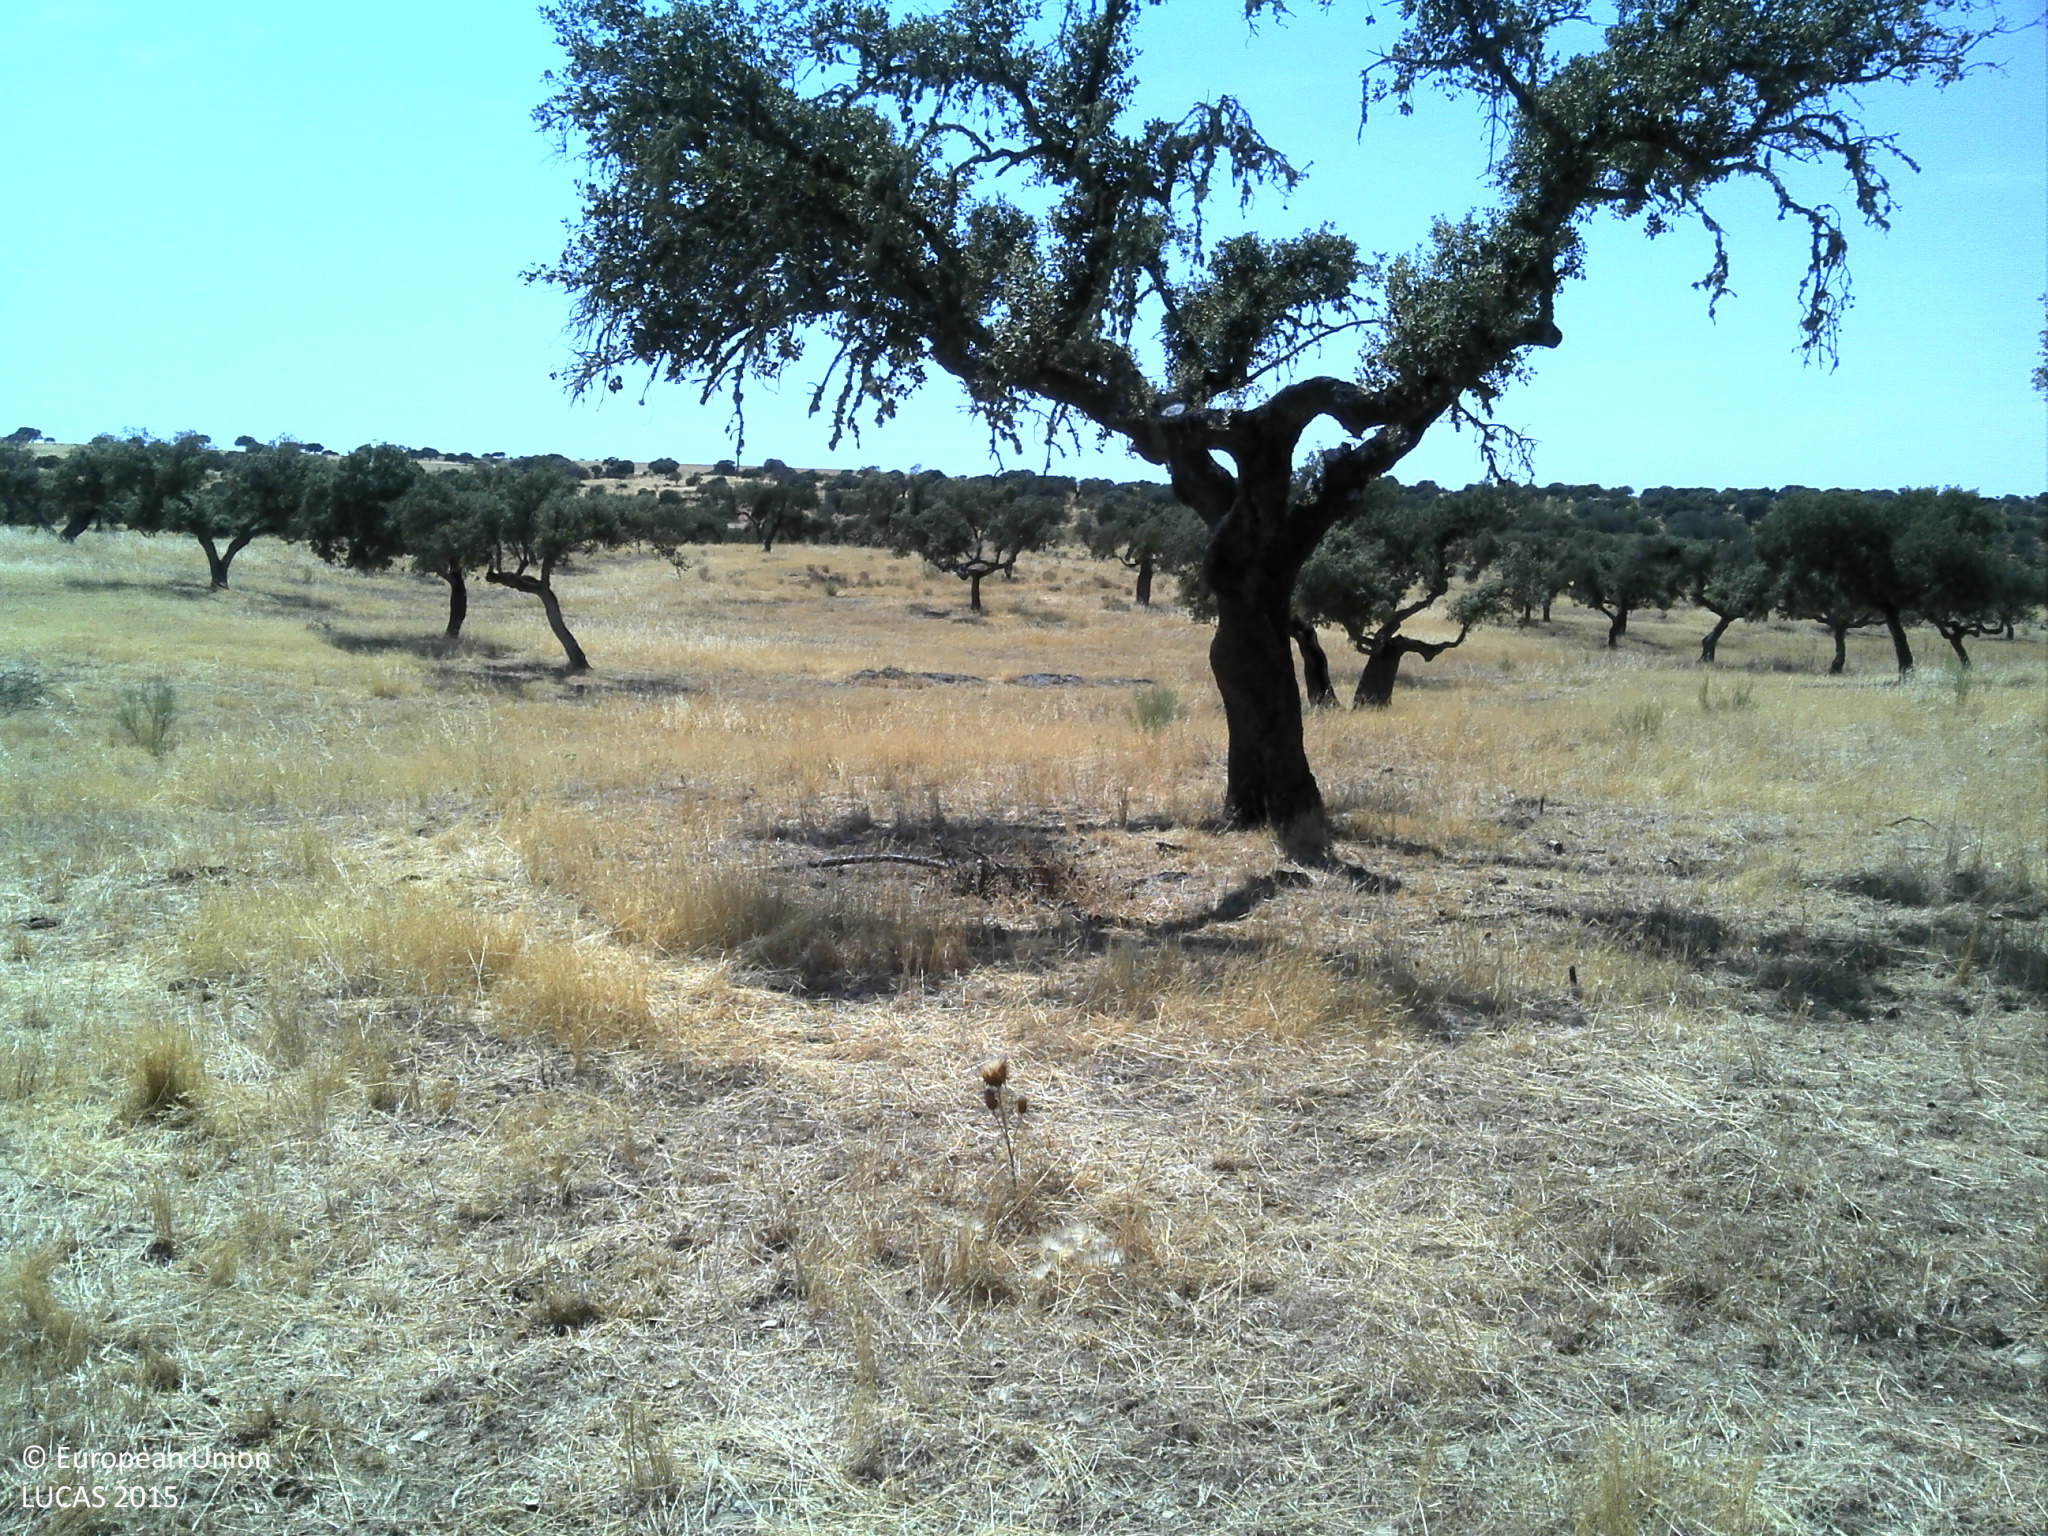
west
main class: Woodland
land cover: Broadleaved woodland
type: broadleaved evergreen forest
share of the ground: 50 - 75 %
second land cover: Grassland without tree/shrub cover
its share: 50 - 75 %
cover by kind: broadleaved forest trees 70 %, herbaceous plants 30 %
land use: Forestry
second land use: Agriculture (excluding fallow land and kitchen gardens)
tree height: > 5 m
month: July
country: PT
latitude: 38.3272
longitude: -7.2119
